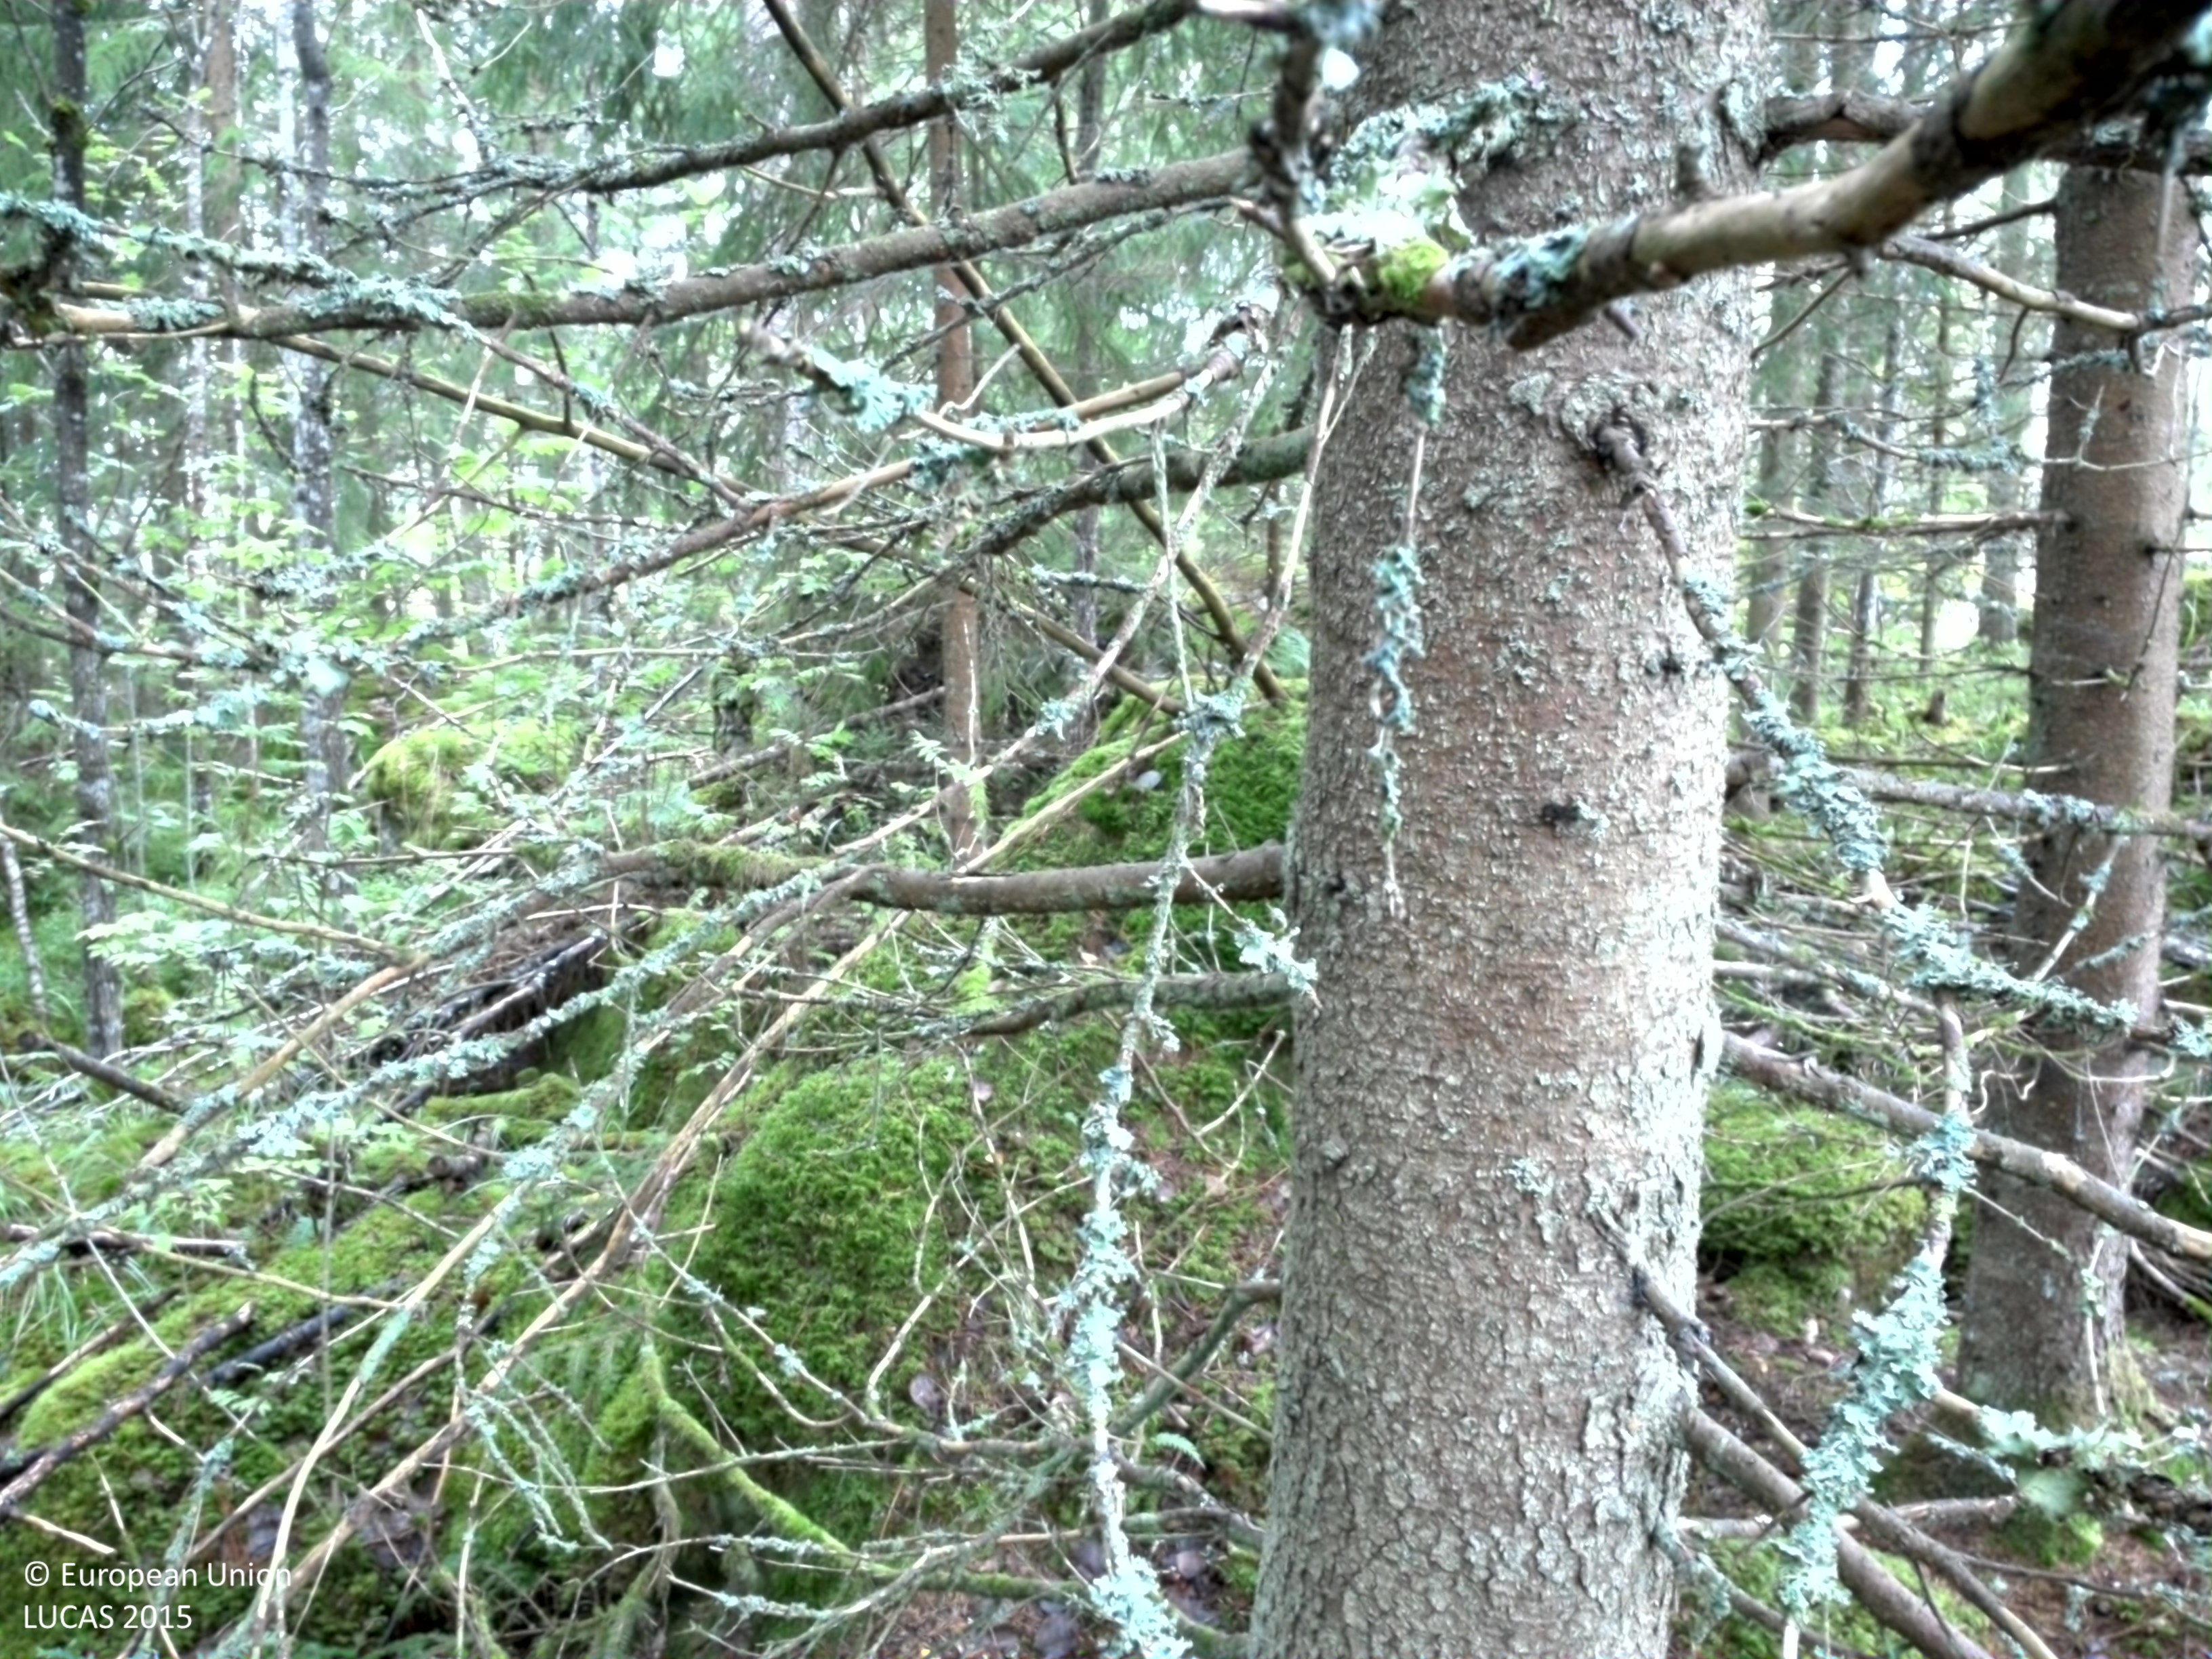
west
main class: Woodland
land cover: Spruce dominated coniferous woodland
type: boreal forest
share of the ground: > 75 %
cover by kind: coniferous forest trees 80 %, broadleaved forest trees 10 %, lichens and mosses 10 %
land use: Forestry
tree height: > 5 m
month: August
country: SE
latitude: 59.9231
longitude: 16.4844
